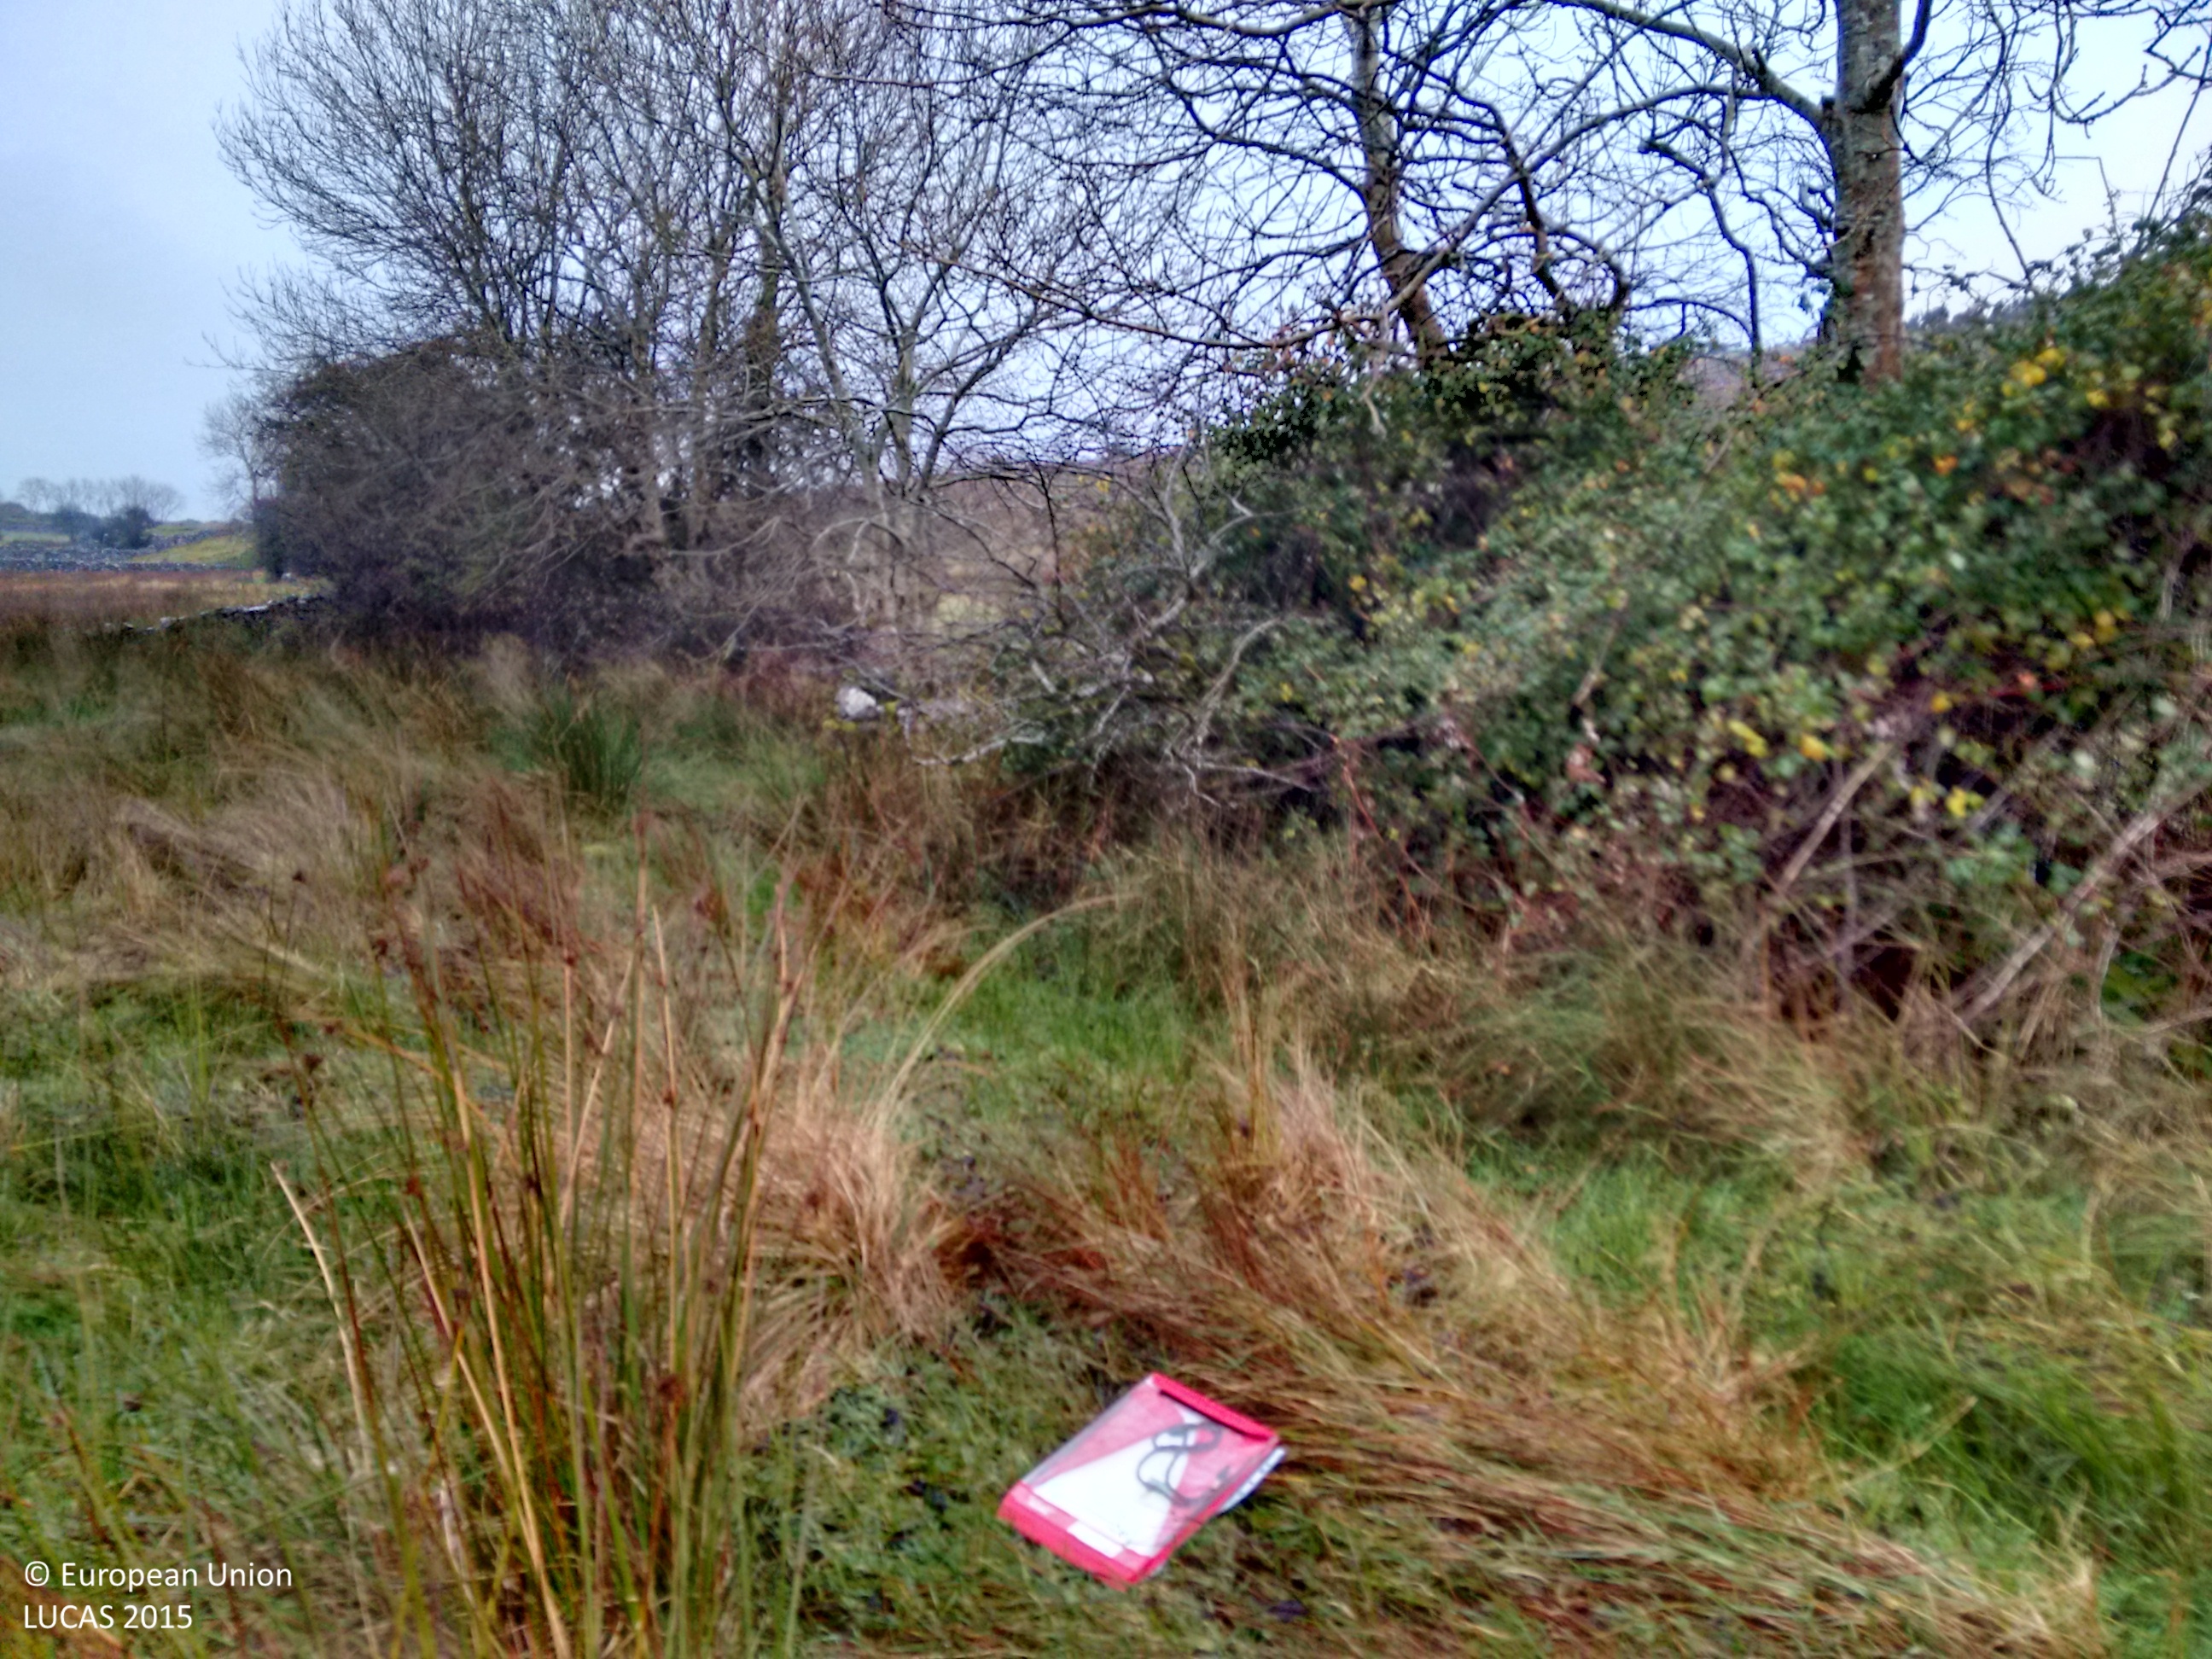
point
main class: Grassland
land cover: Grassland without tree/shrub cover
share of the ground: > 75 %
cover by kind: herbaceous plants 100 %
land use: Agriculture (excluding fallow land and kitchen gardens)
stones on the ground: < 10 %
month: November
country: IE
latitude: 54.5469
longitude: -8.1253
